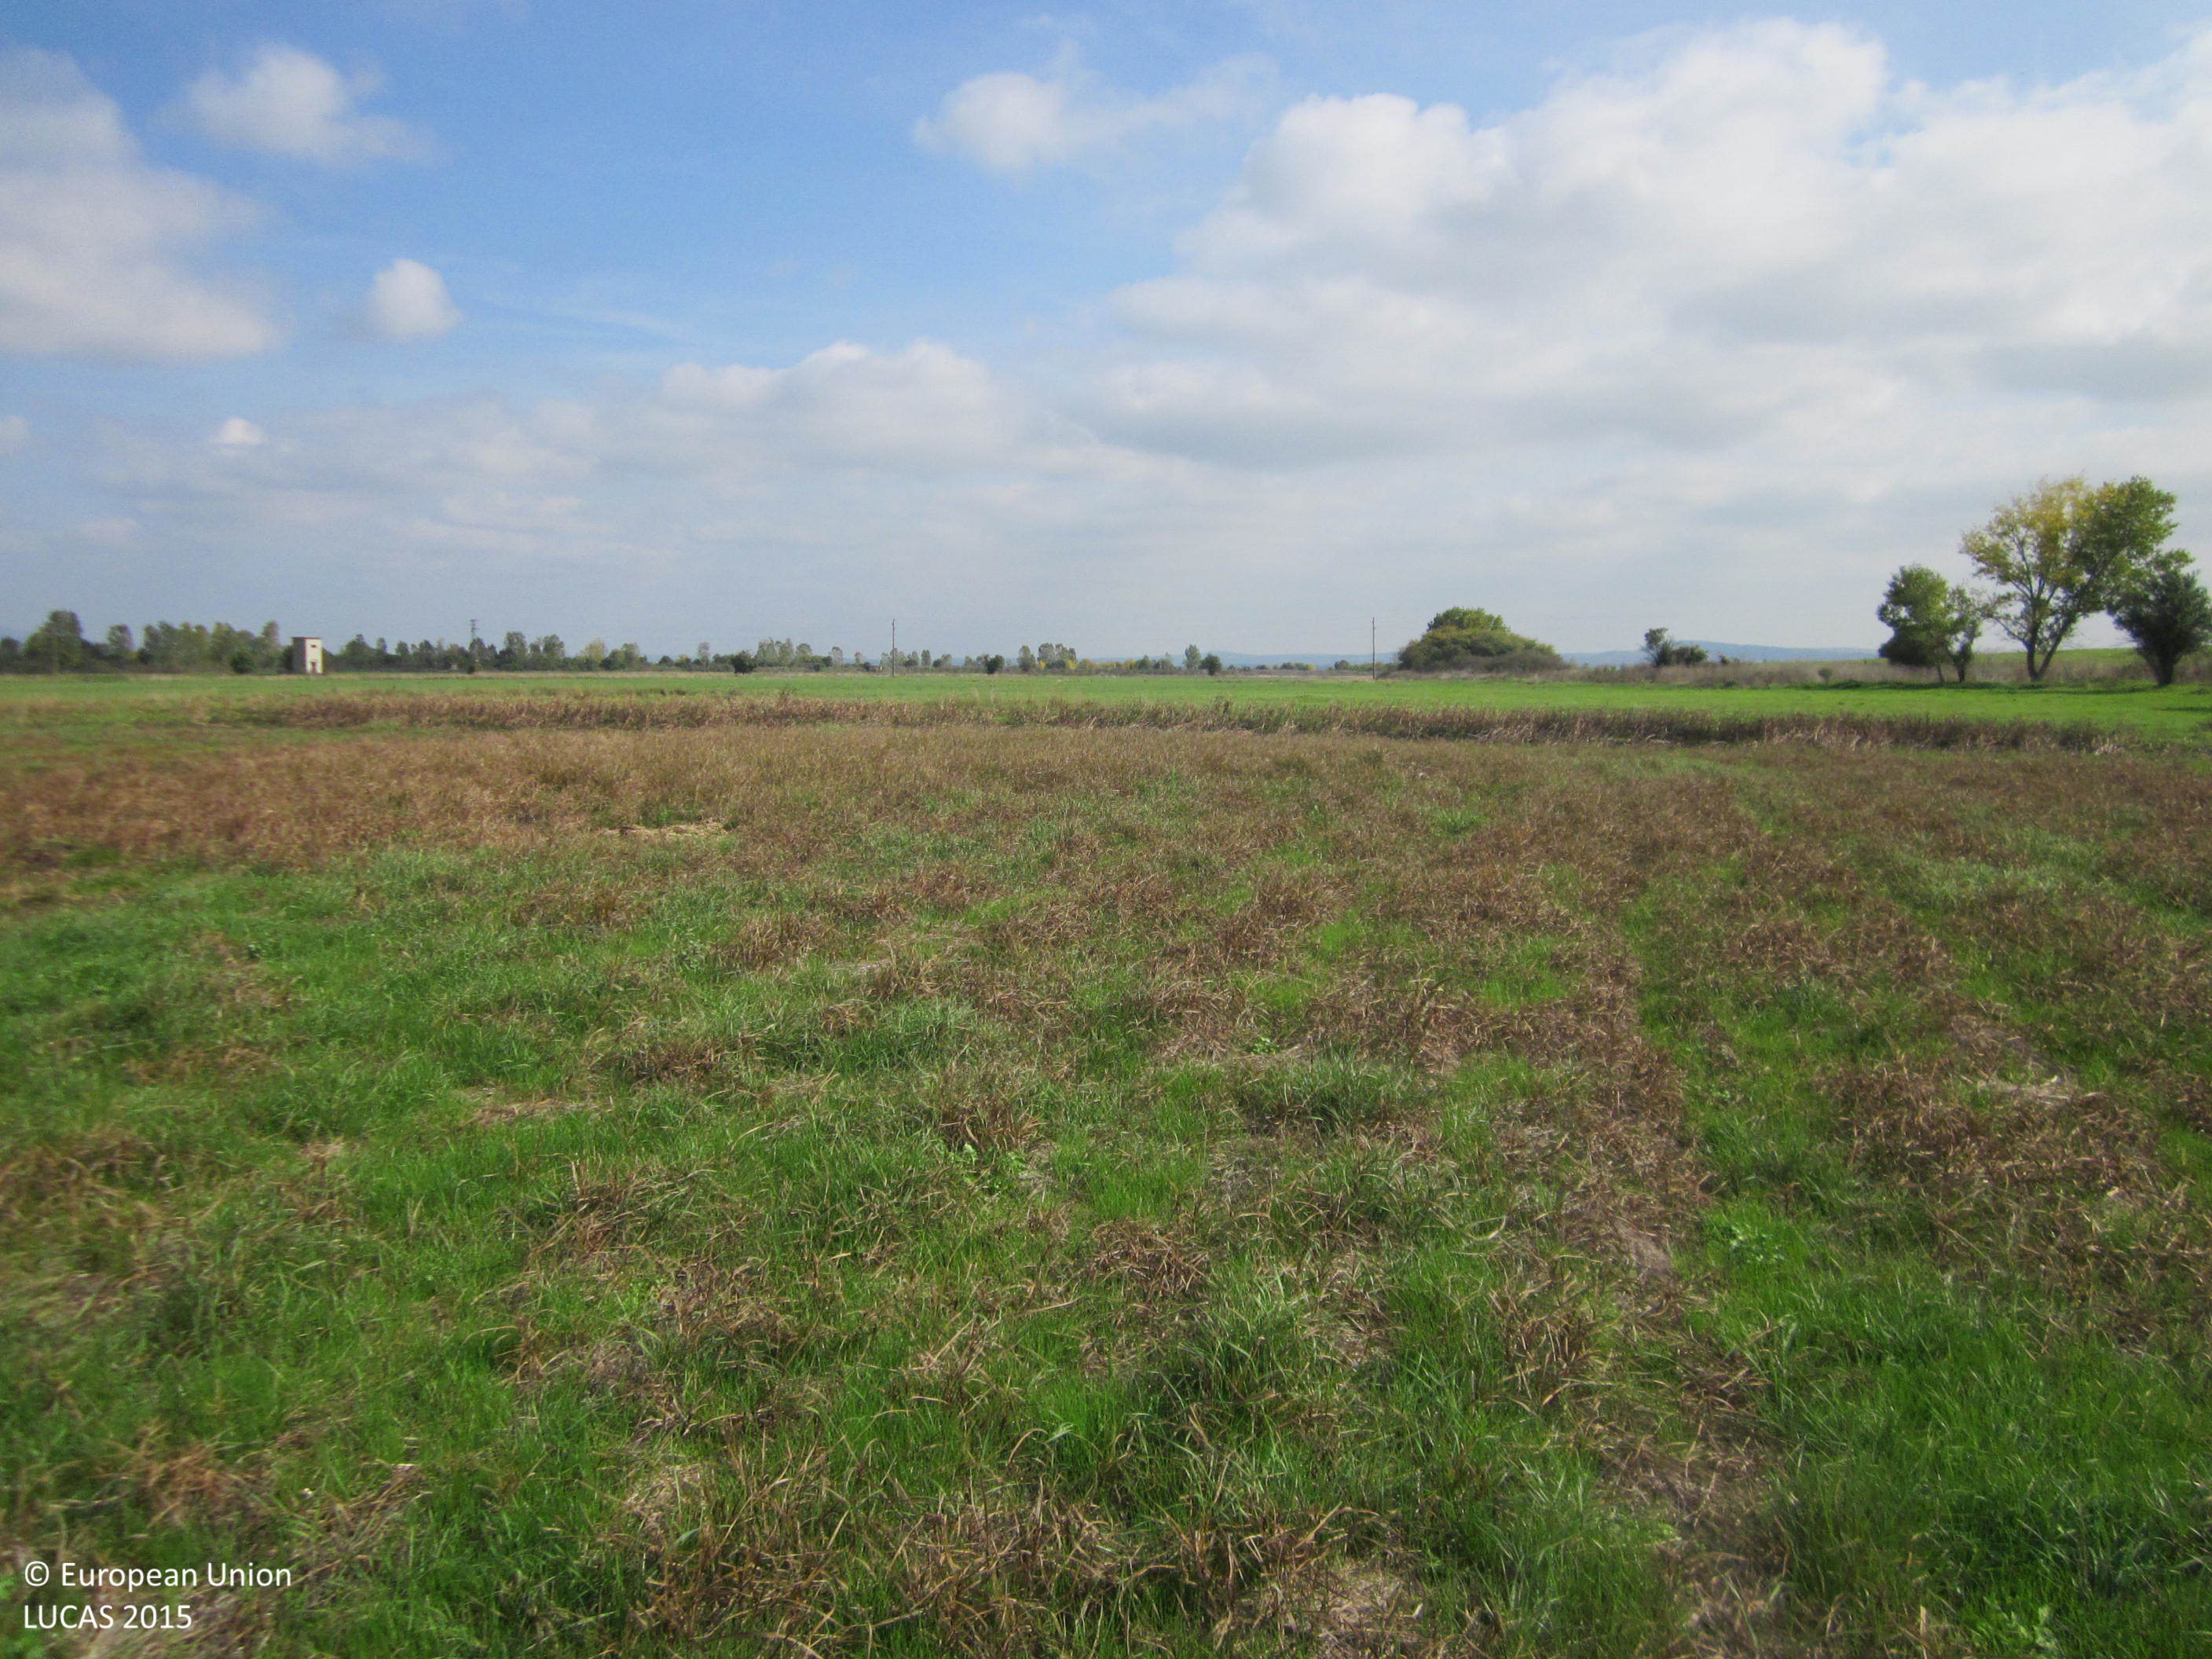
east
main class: Grassland
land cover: Grassland without tree/shrub cover
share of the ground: > 75 %
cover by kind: herbaceous plants 100 %
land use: Agriculture (excluding fallow land and kitchen gardens)
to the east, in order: Grassland without tree/shrub cover
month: October
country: BG
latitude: 42.6964
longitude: 26.8888
